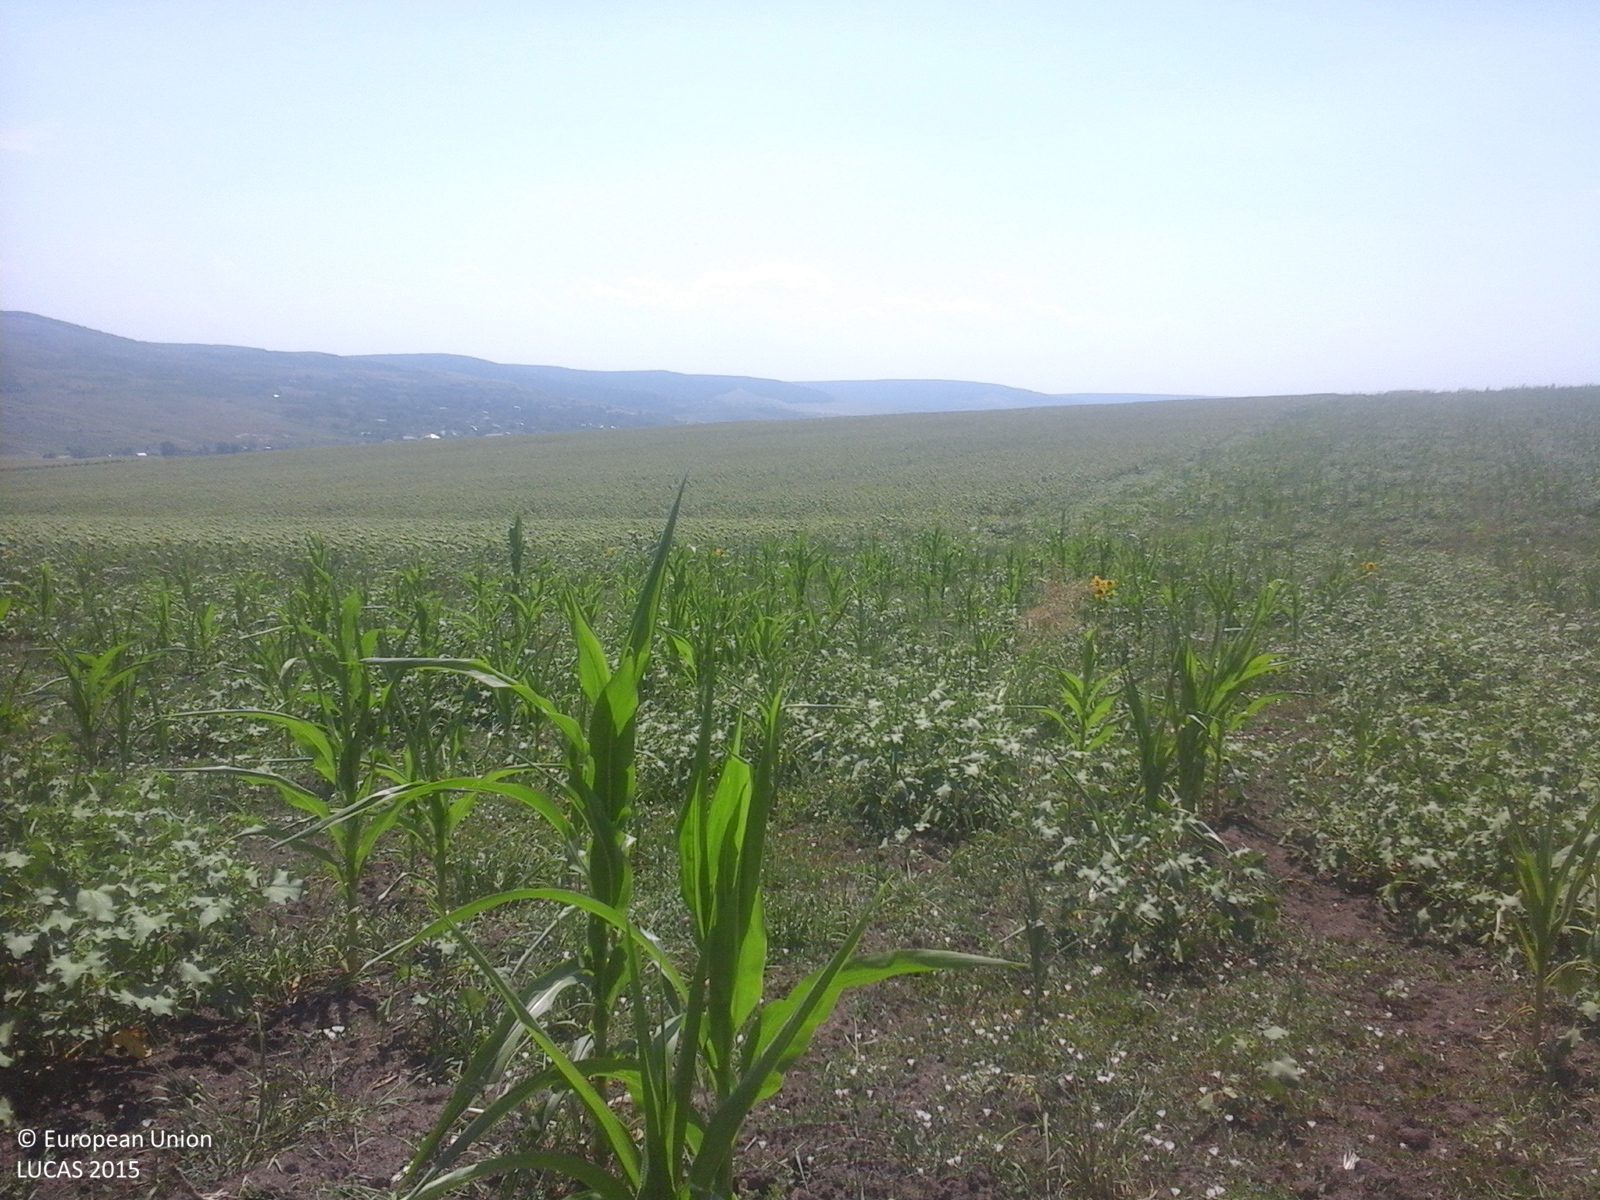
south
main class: Cropland
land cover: Maize
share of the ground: 50 - 75 %
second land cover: Spontaneously vegetated surfaces
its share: 25 - 50 %
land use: Agriculture (excluding fallow land and kitchen gardens)
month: July
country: RO
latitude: 46.6575
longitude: 27.9644
